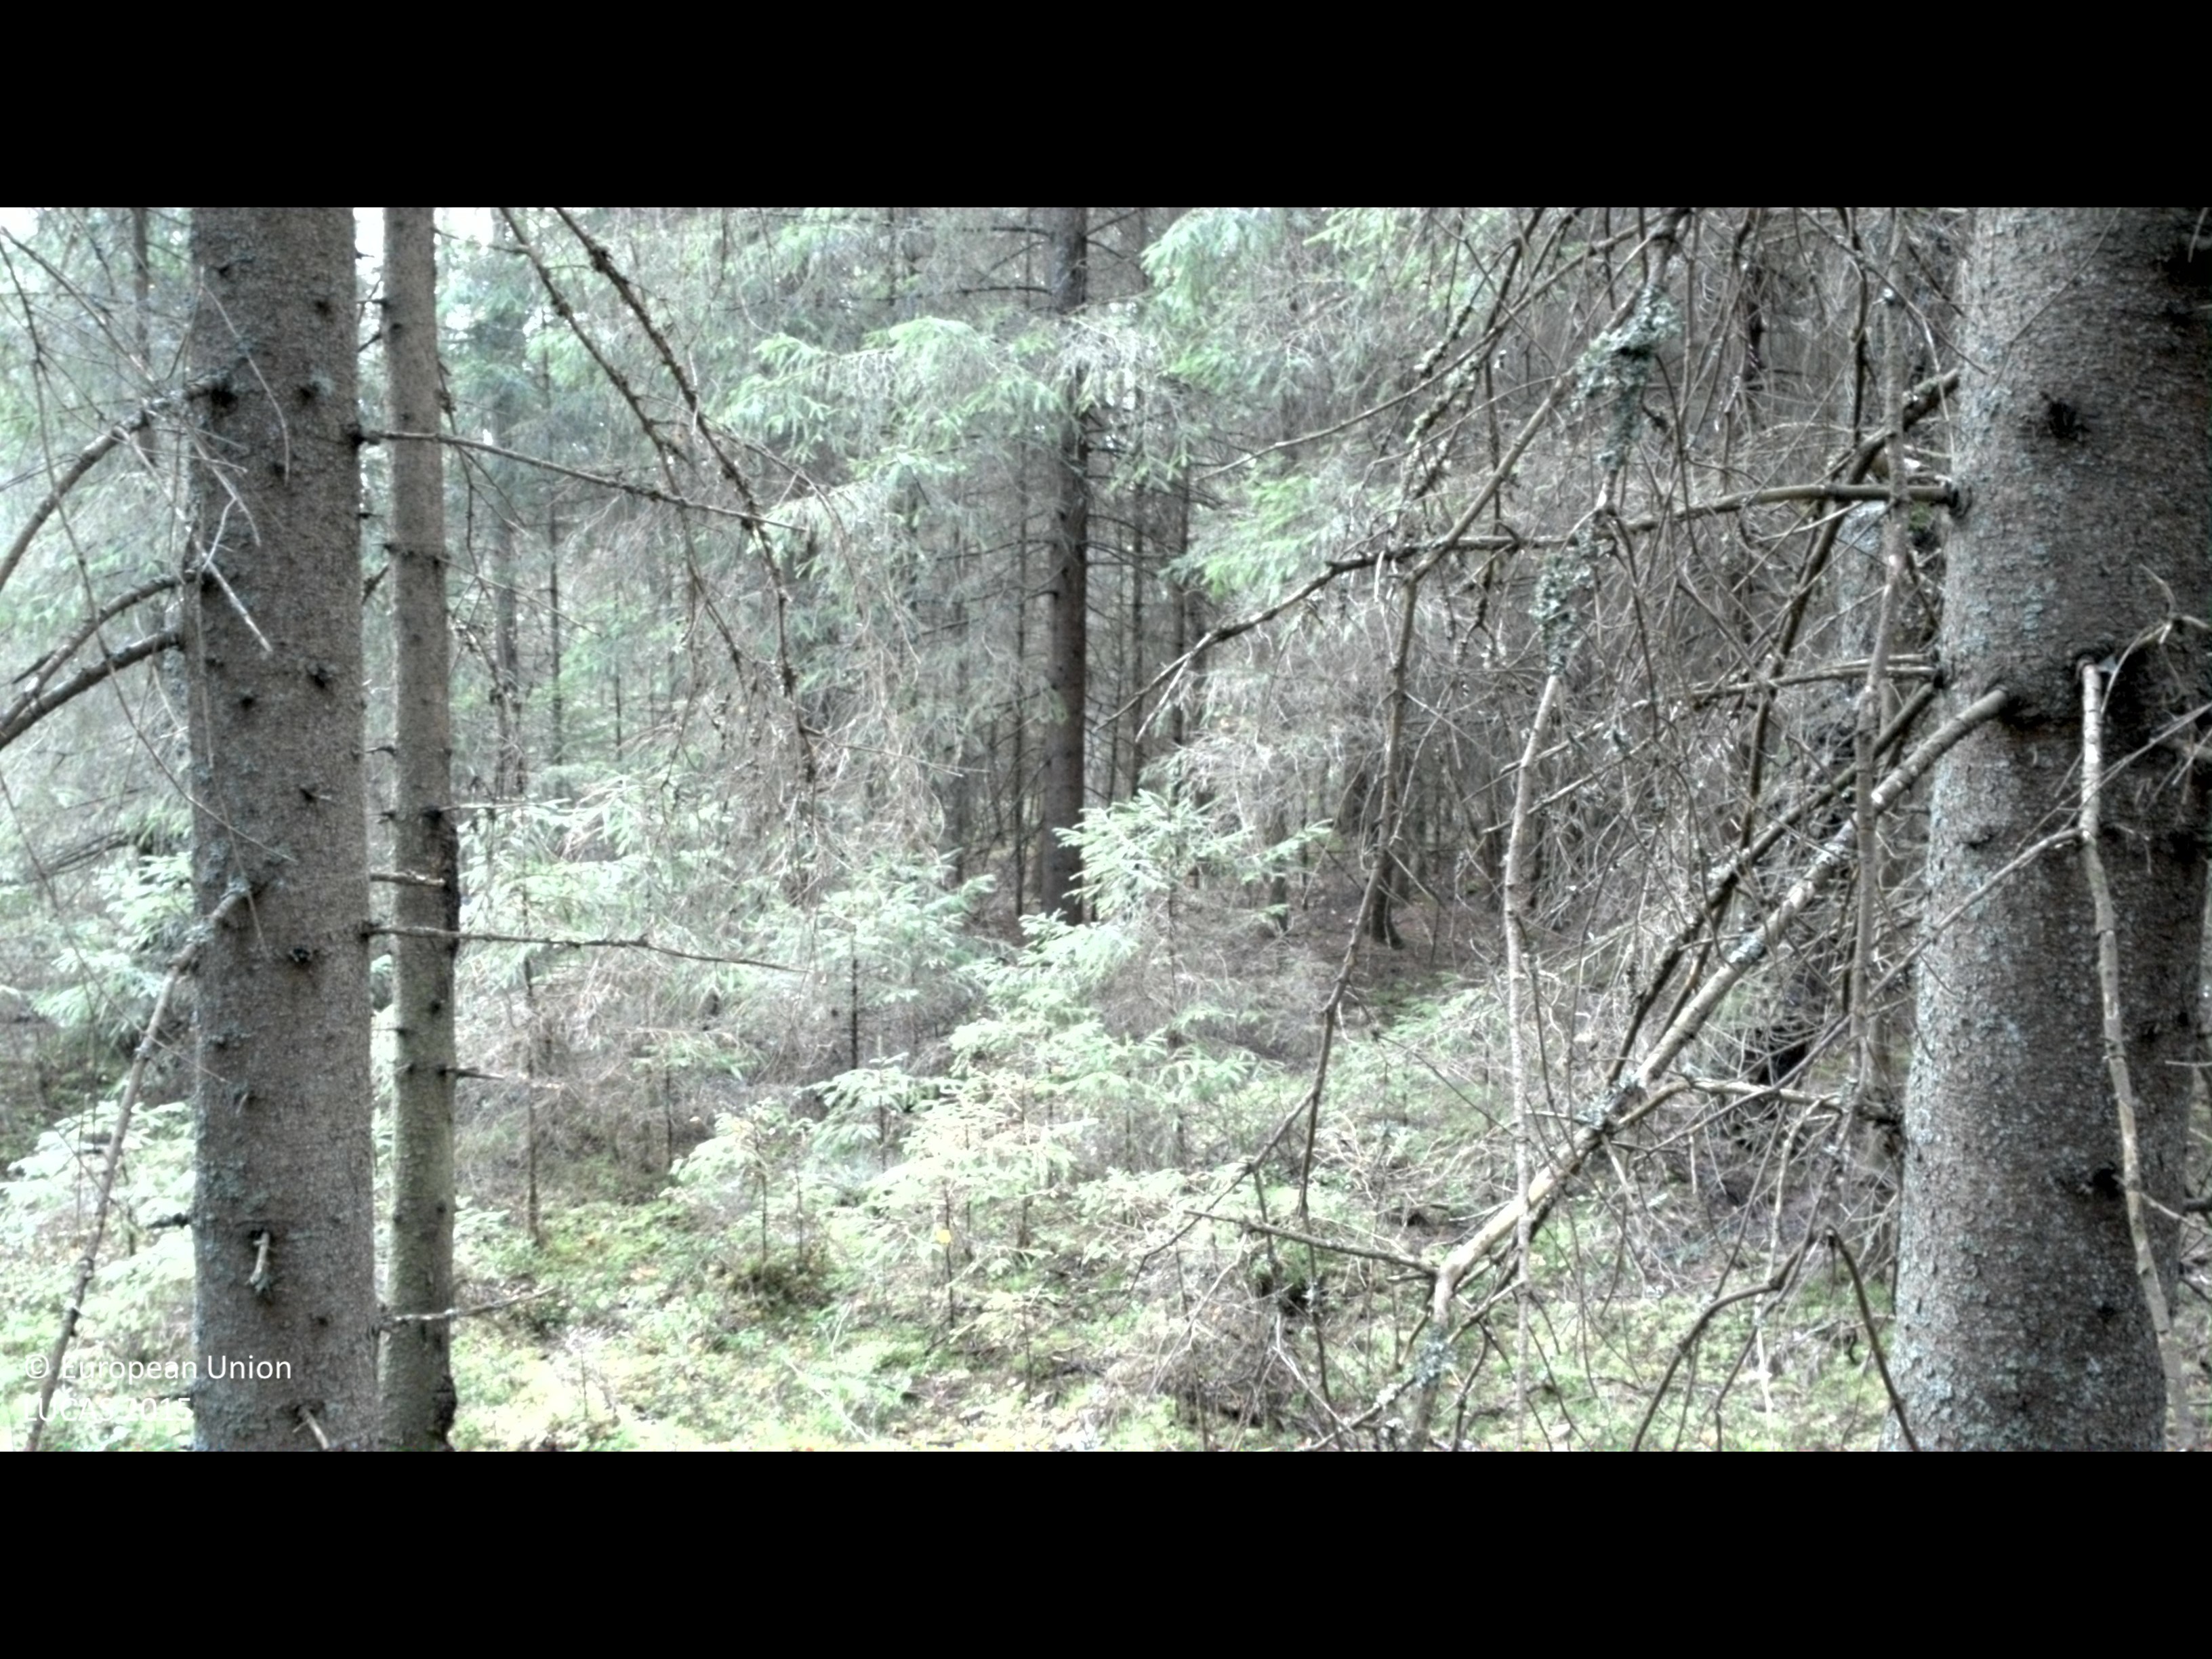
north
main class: Woodland
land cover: Spruce dominated coniferous woodland
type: boreal forest
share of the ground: > 75 %
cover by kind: coniferous forest trees 75 %, shrubs 15 %, broadleaved forest trees 5 %, lichens and mosses 5 %
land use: Forestry
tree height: > 5 m
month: August
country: SE
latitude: 56.9404
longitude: 13.1687
